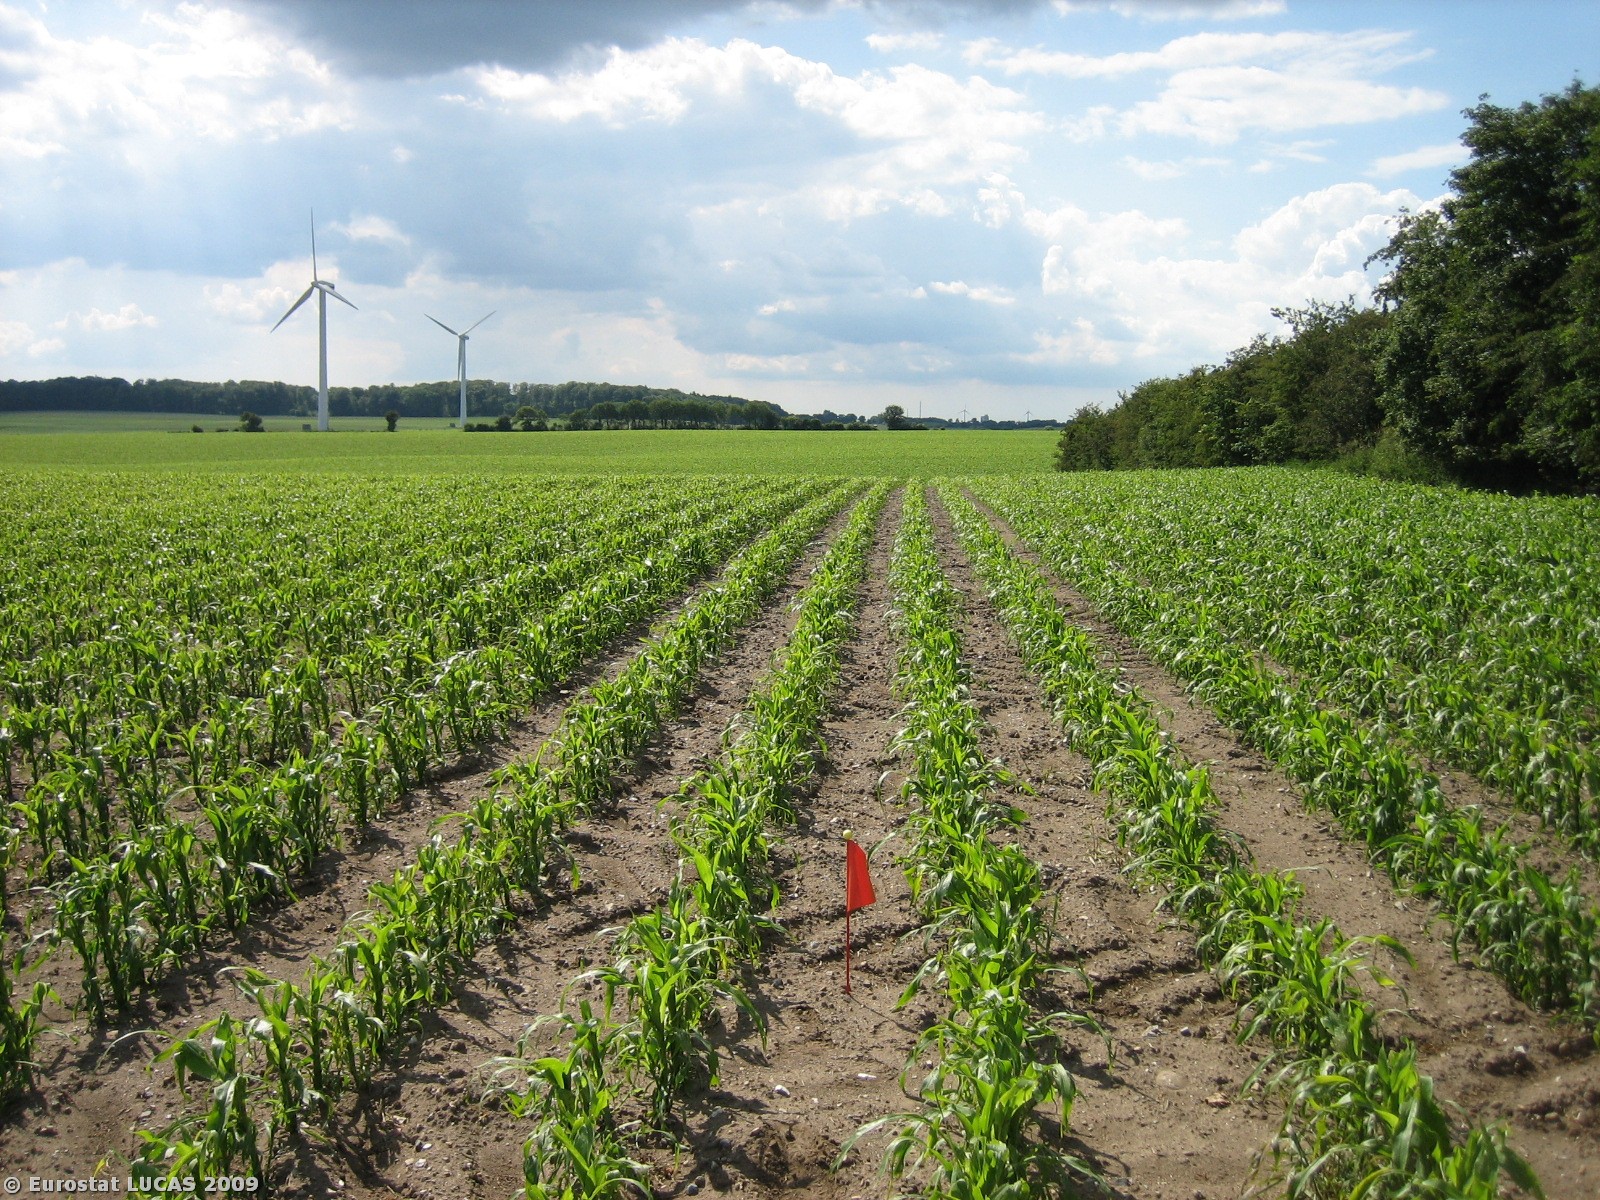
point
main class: Cropland
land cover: Maize
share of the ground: 10 - 25 %
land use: Agriculture (excluding fallow land and kitchen gardens)
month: June
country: DK
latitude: 55.4667
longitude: 9.2889
